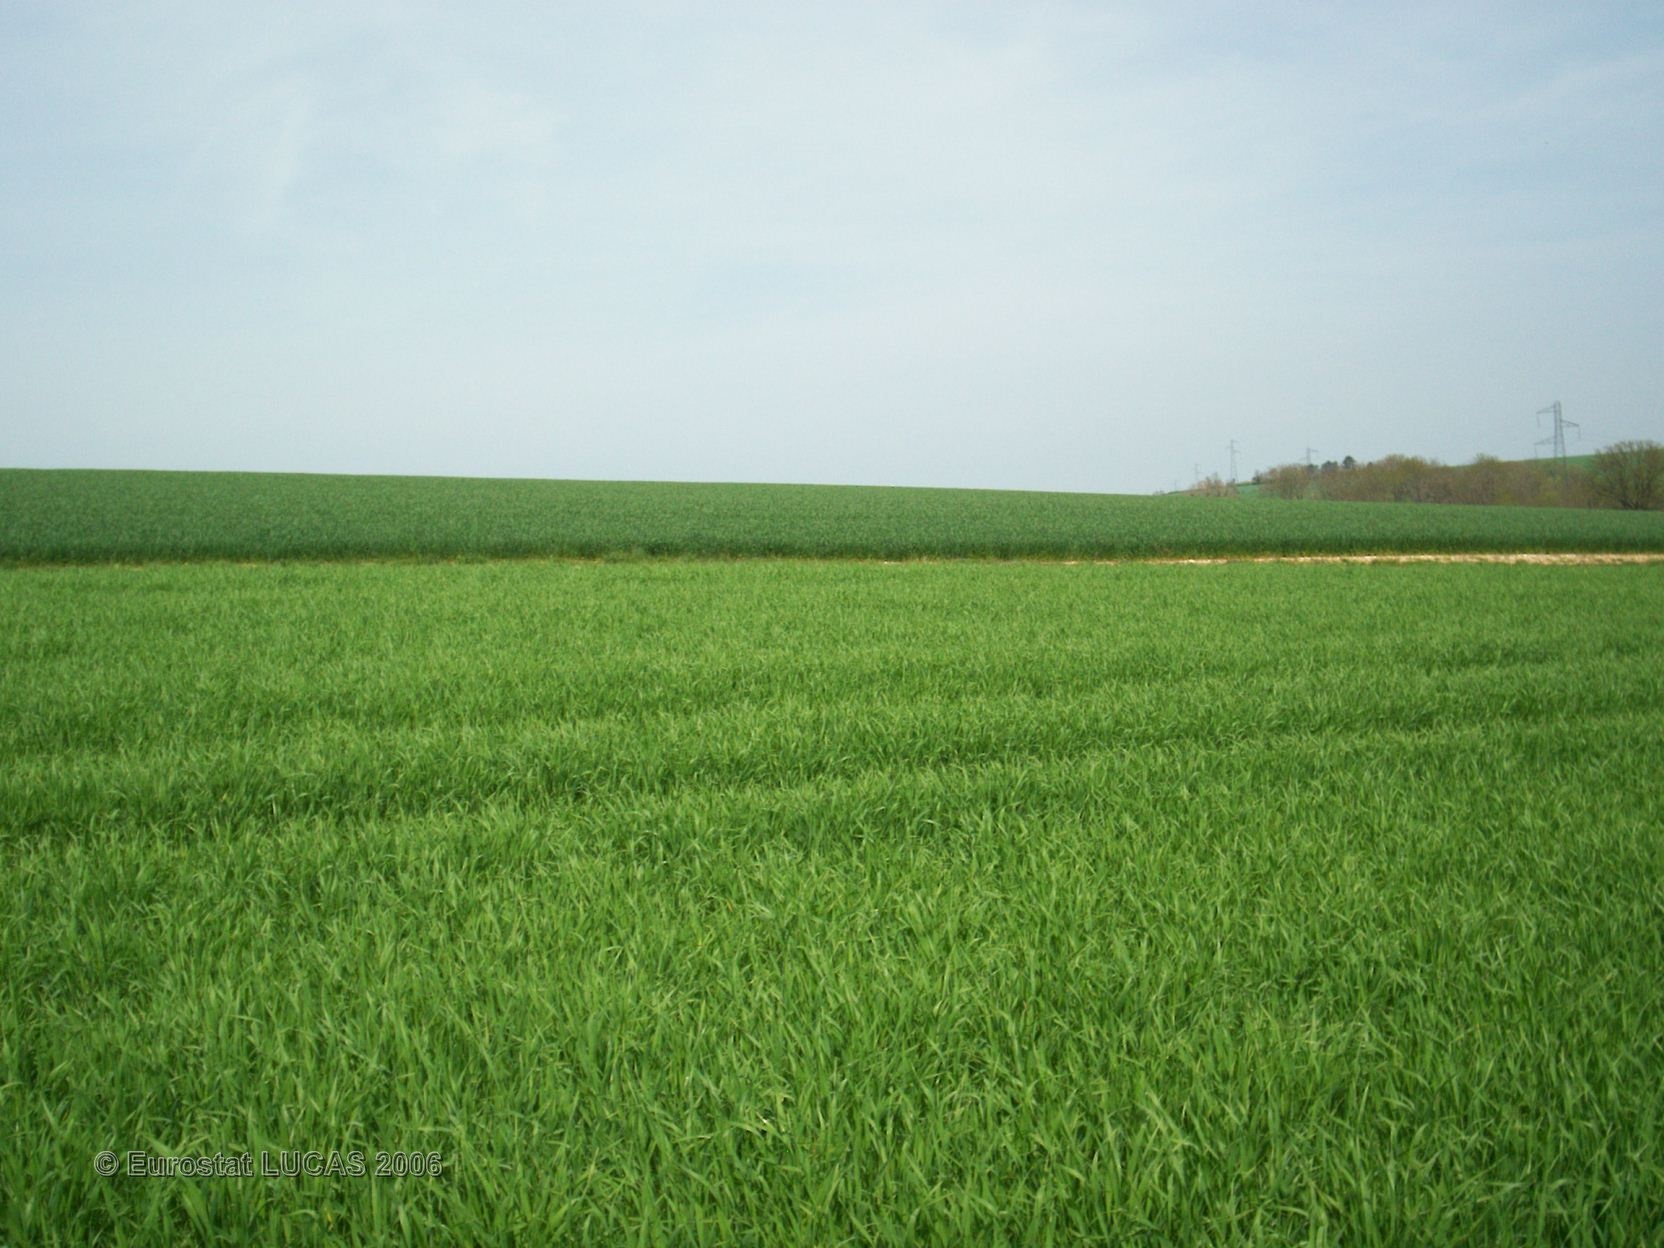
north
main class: Cropland
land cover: Barley
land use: Agriculture (excluding fallow land and kitchen gardens)
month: May
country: FR
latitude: 47.6188
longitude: 4.5305
